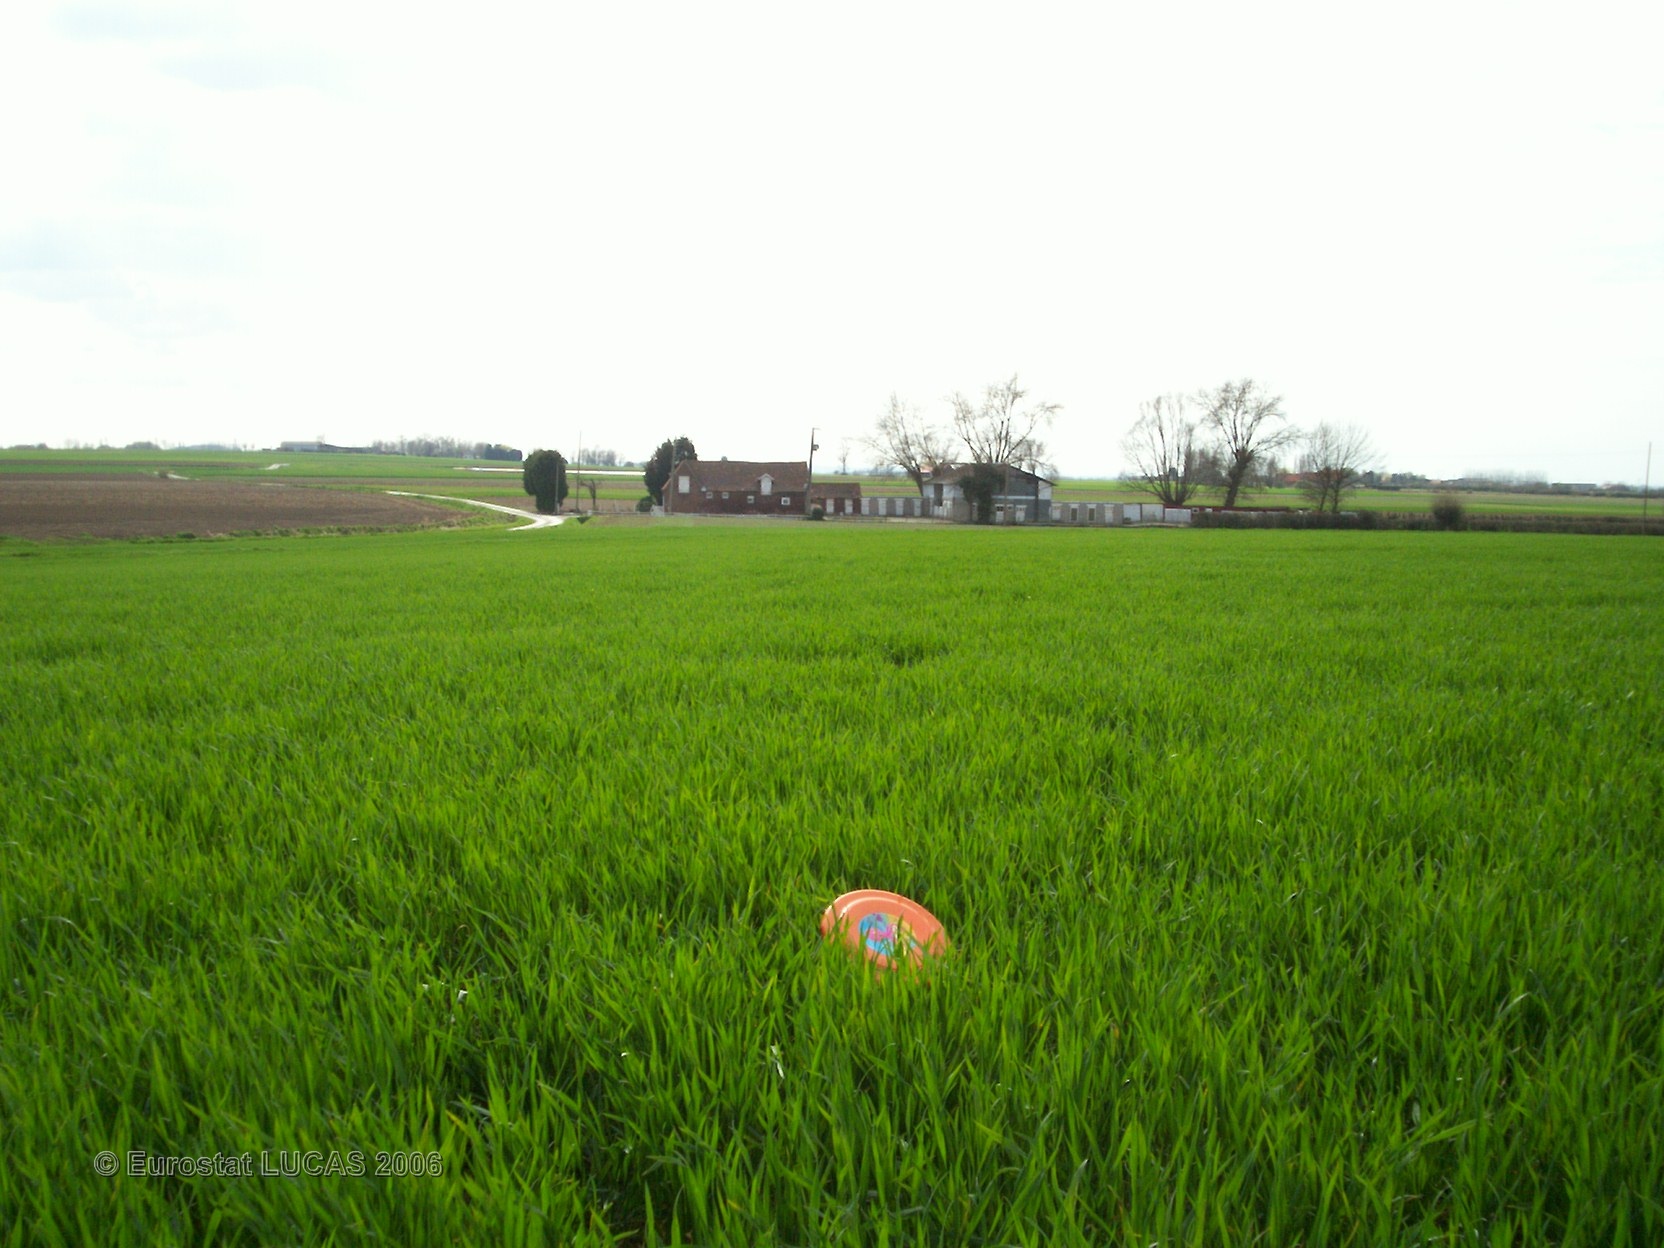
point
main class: Cropland
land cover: Common wheat
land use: Agriculture (excluding fallow land and kitchen gardens)
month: April
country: FR
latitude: 50.8846
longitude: 2.3532
